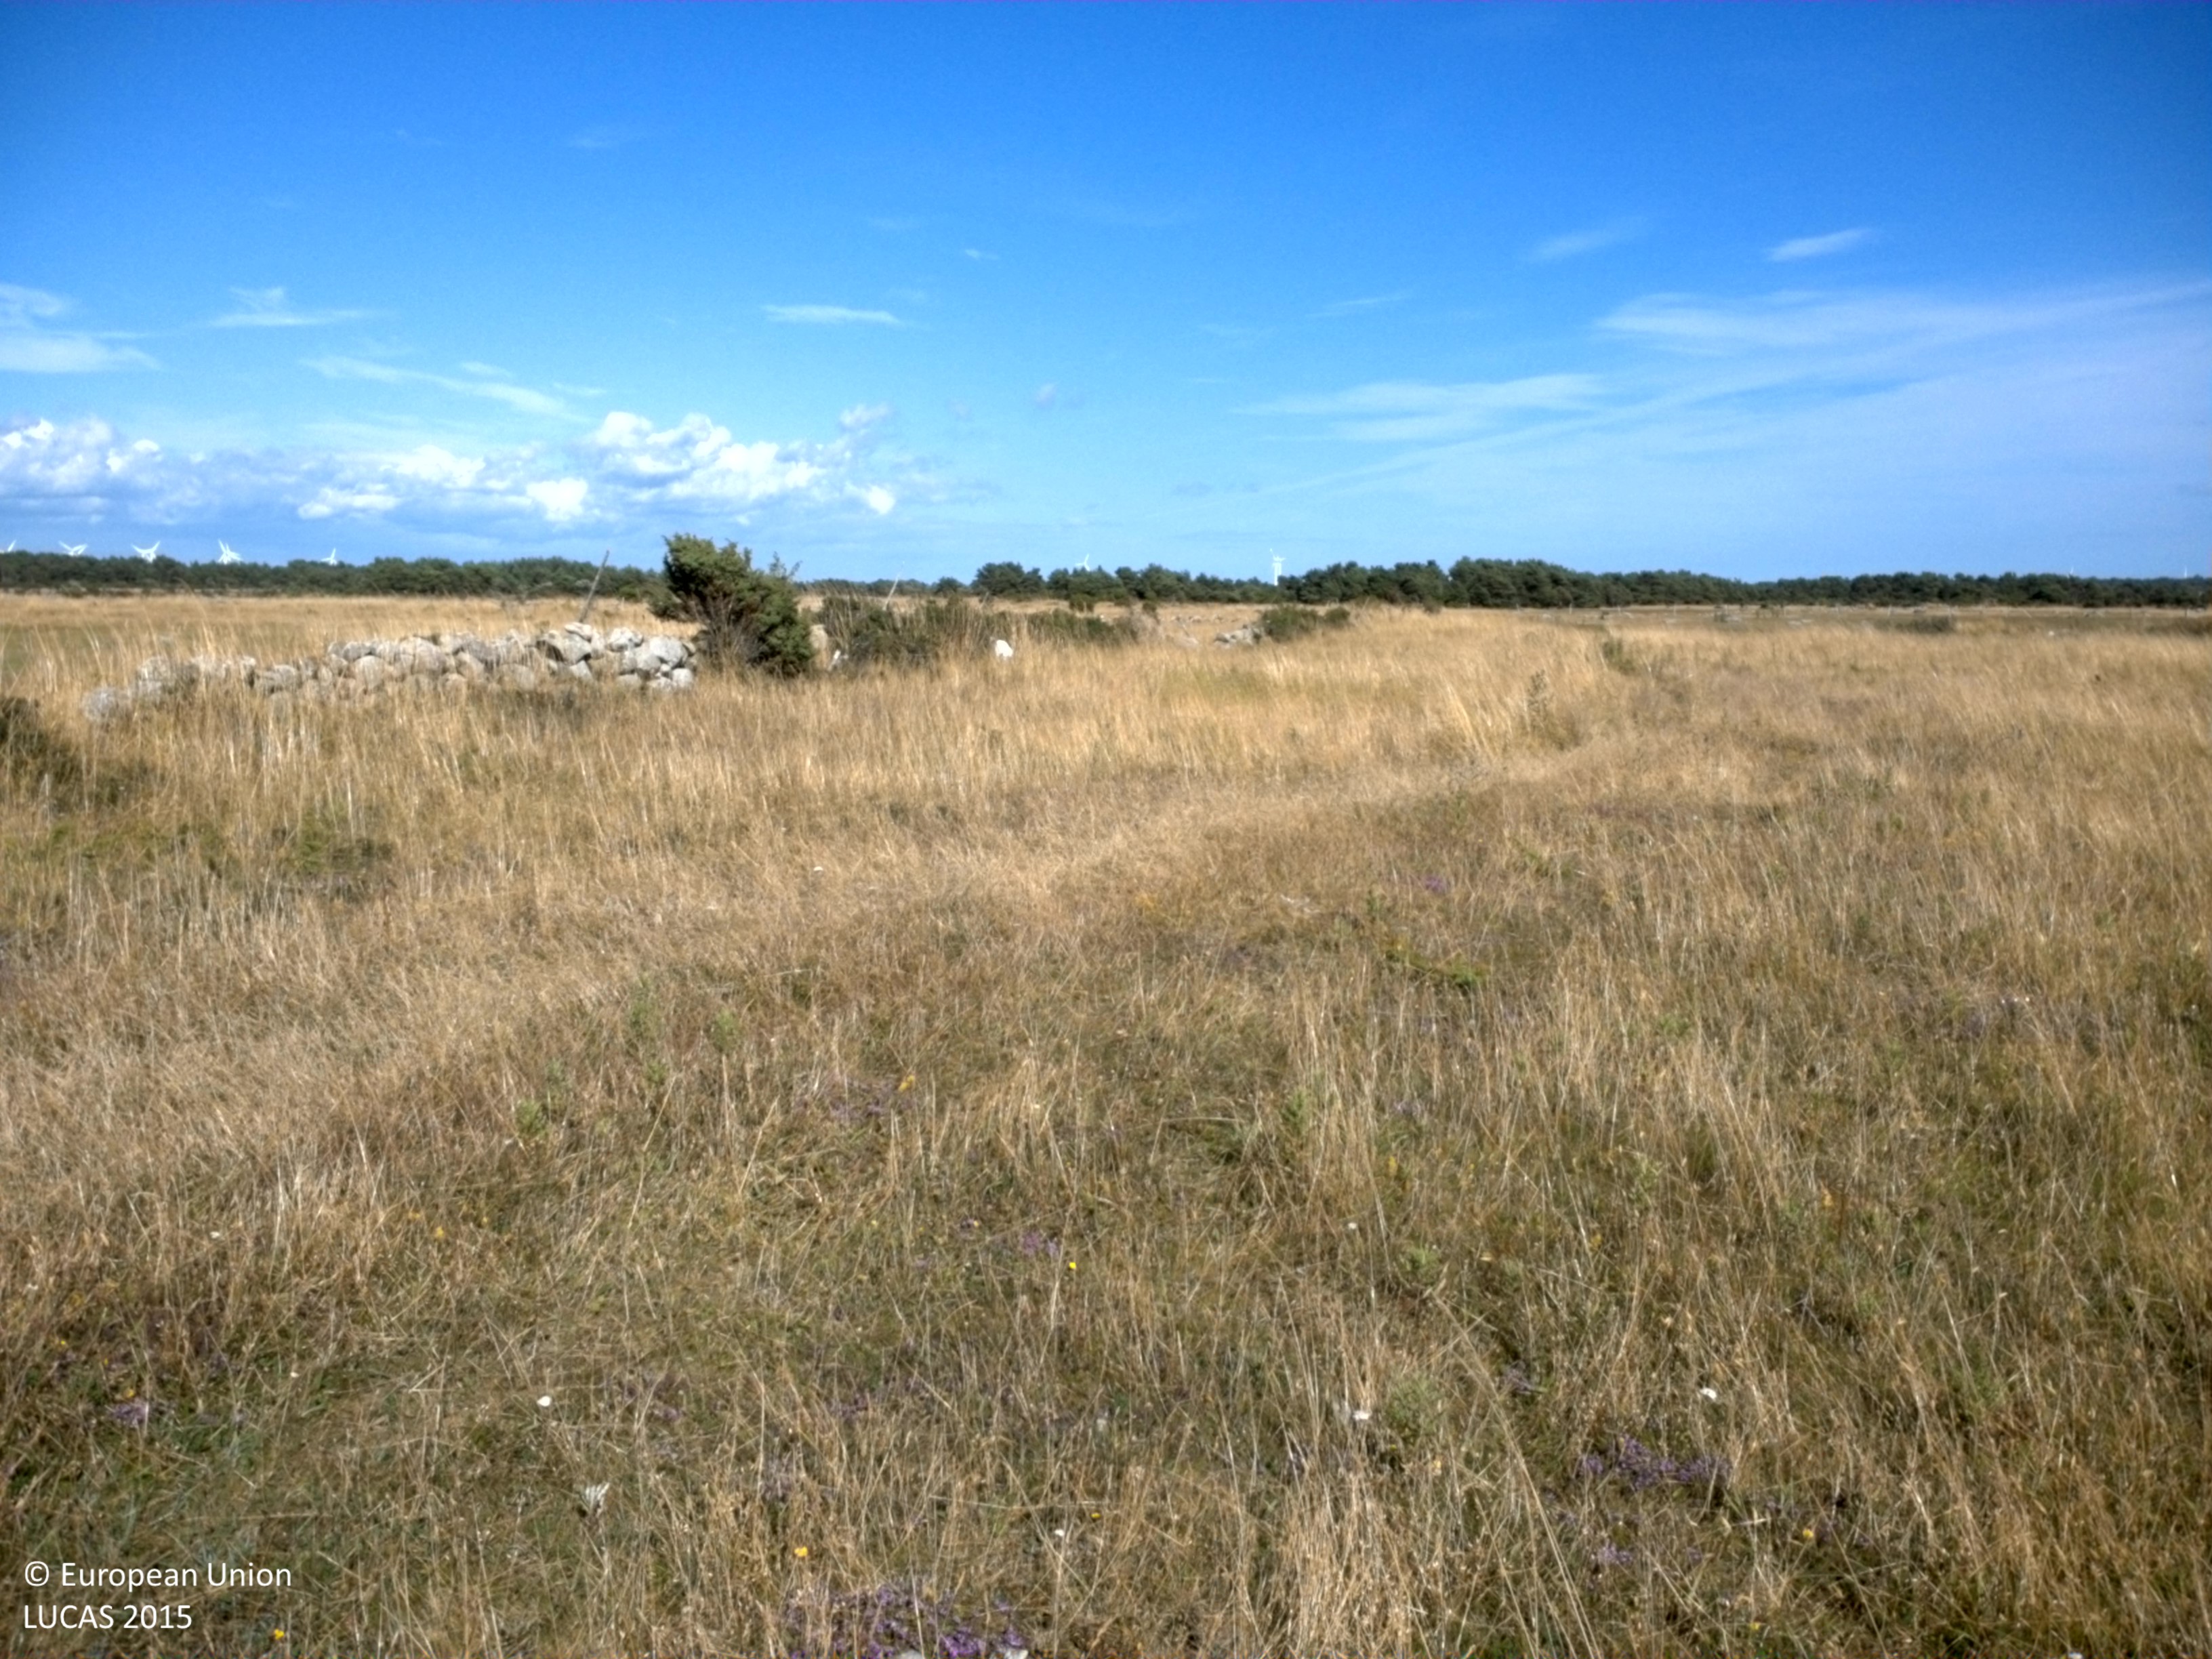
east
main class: Grassland
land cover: Grassland without tree/shrub cover
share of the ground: > 75 %
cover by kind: herbaceous plants 100 %
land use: Agriculture (excluding fallow land and kitchen gardens)
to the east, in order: Grassland without tree/shrub cover; Tracks; Grassland without tree/shrub cover; Fences; Grassland without tree/shrub cover; Tracks; Grassland without tree/shrub cover
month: July
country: SE
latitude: 57.1176
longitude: 18.2160
